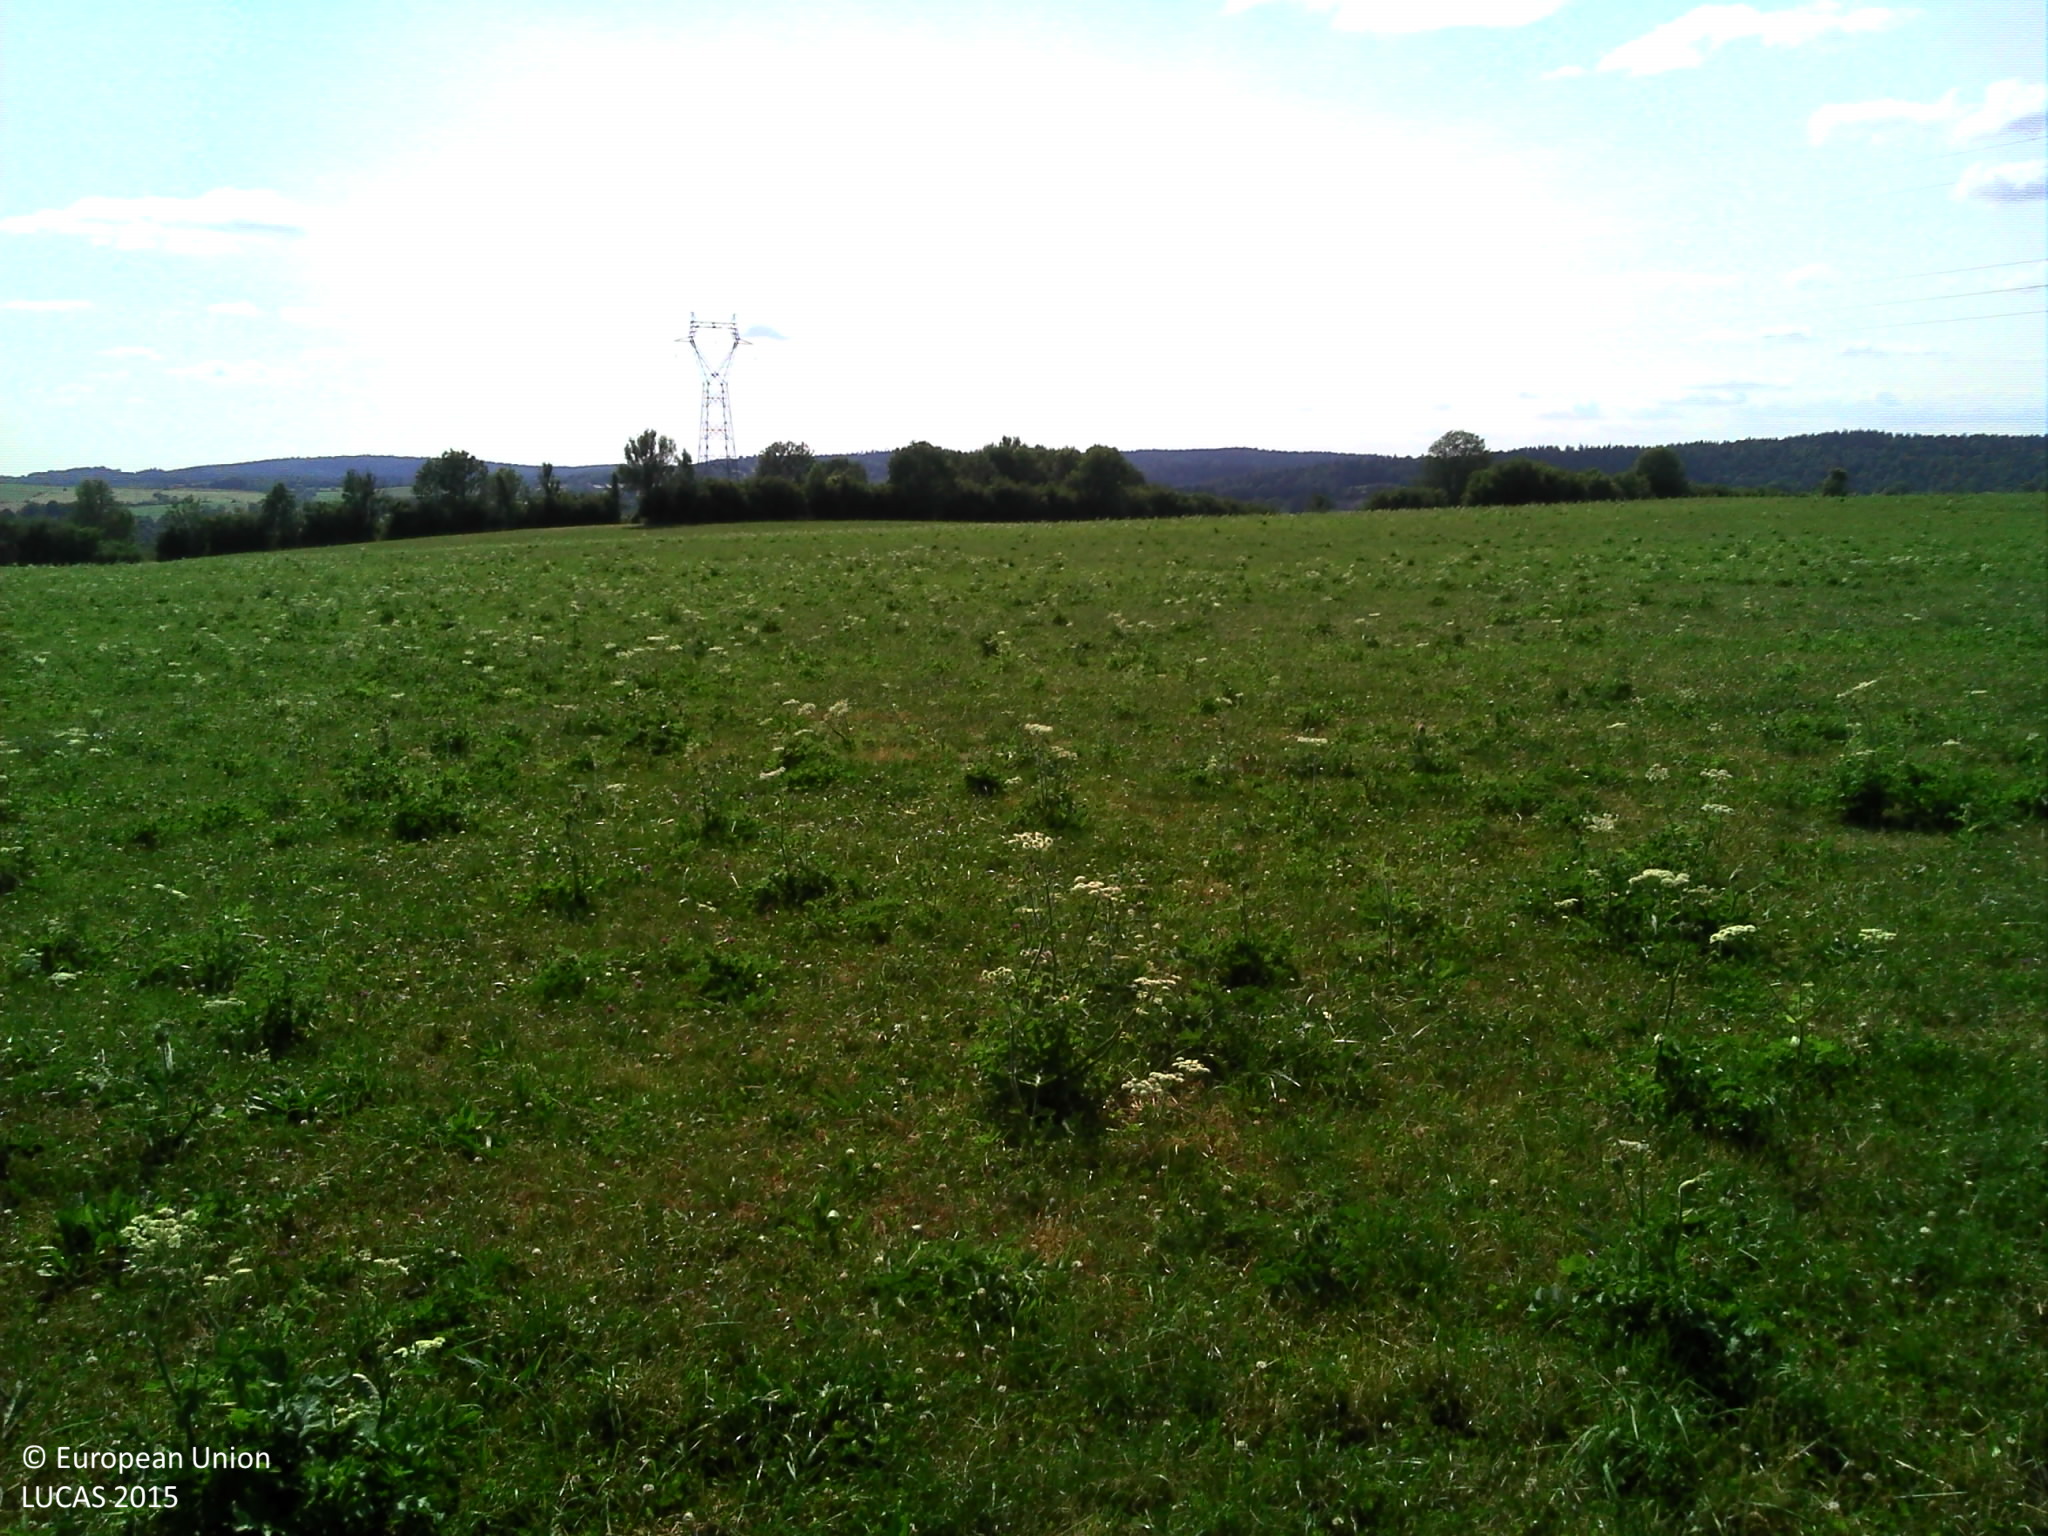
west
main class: Grassland
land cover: Grassland without tree/shrub cover
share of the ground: > 75 %
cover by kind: herbaceous plants 100 %
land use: Agriculture (excluding fallow land and kitchen gardens)
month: July
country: FR
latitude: 46.8015
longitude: 6.0585
